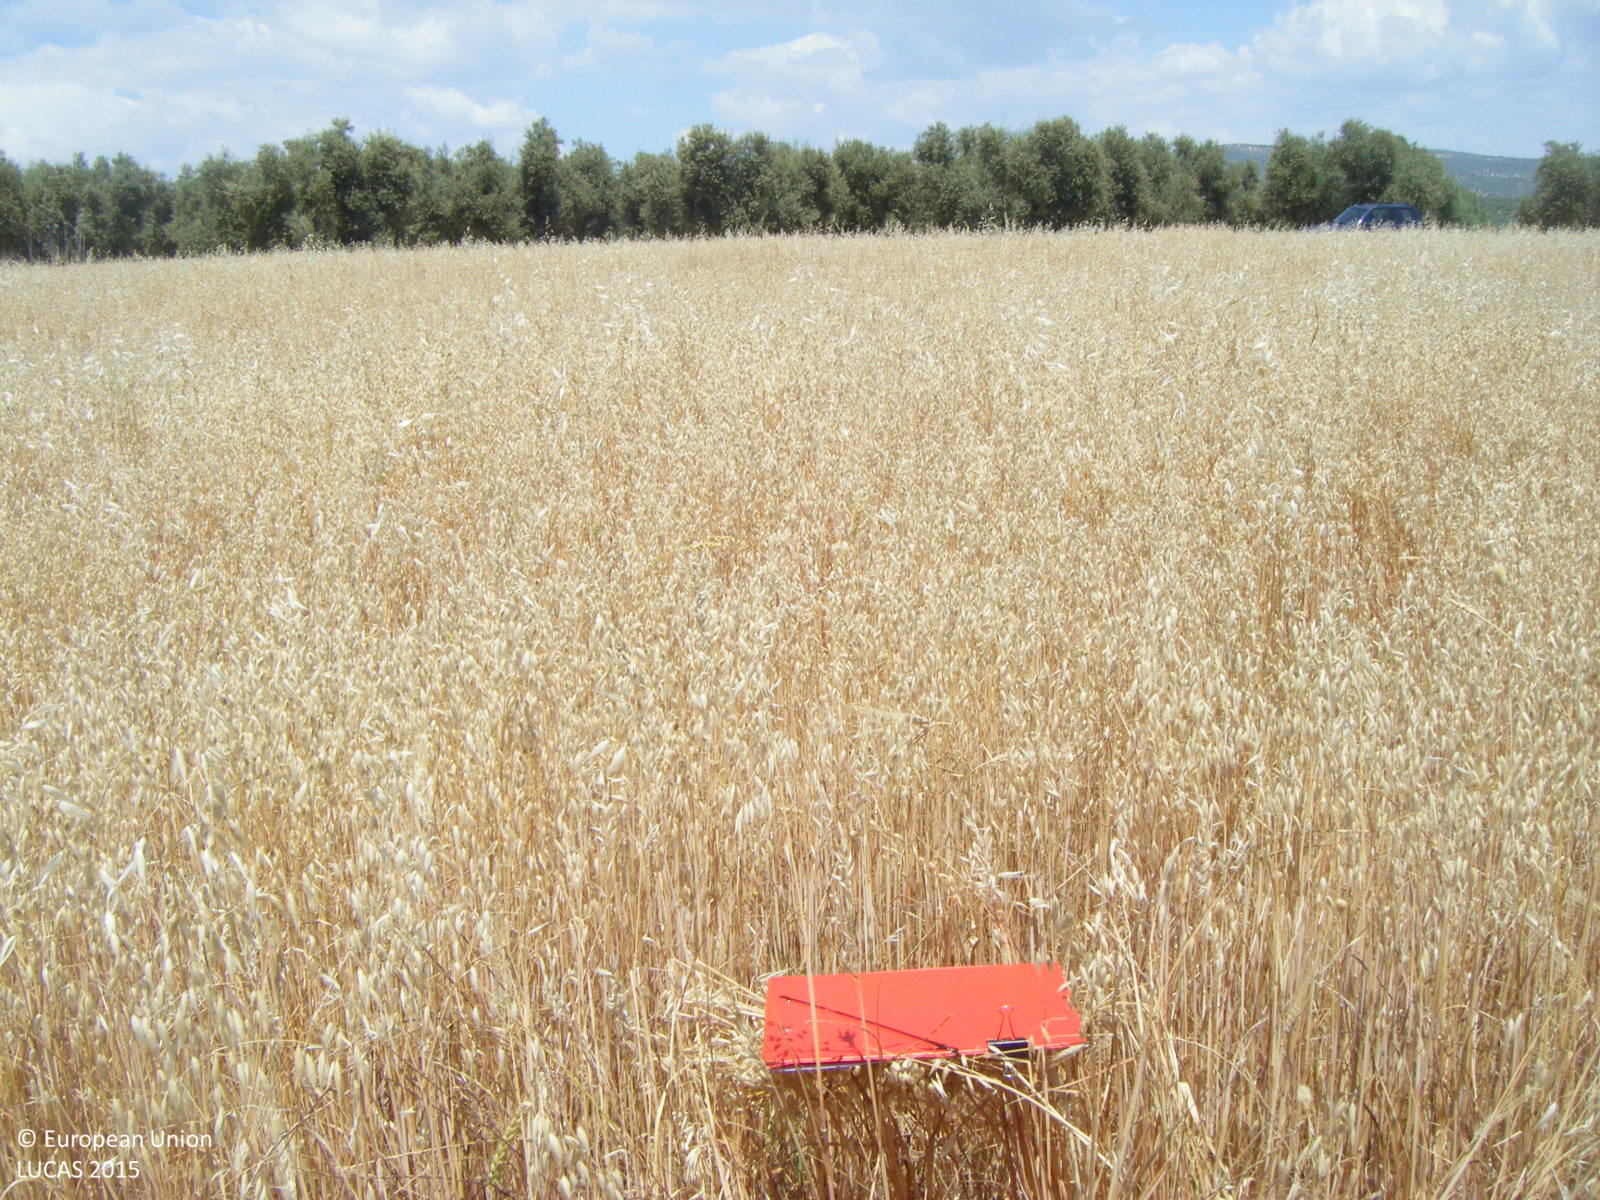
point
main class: Cropland
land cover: Oats
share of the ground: > 75 %
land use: Agriculture (excluding fallow land and kitchen gardens)
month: May
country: ES
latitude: 37.2000
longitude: -4.4993
